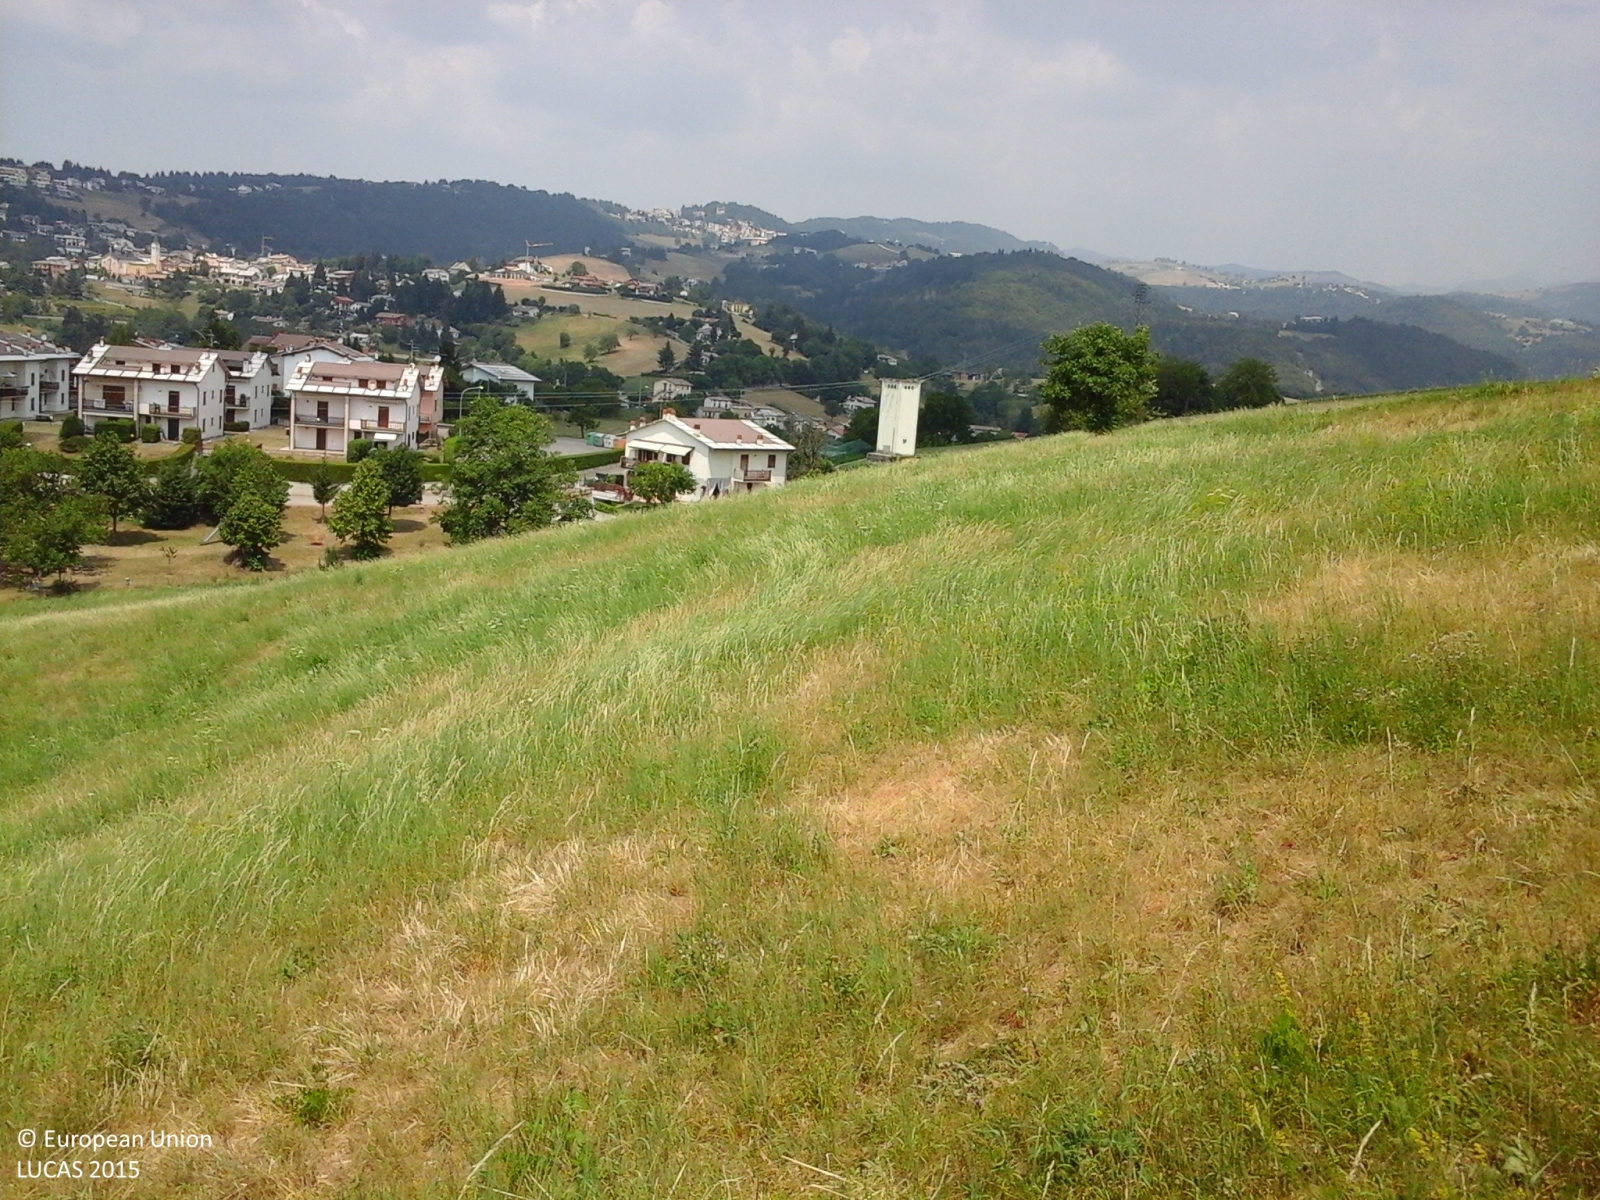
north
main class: Grassland
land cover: Grassland with sparse tree/shrub cover
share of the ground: > 75 %
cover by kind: herbaceous plants 85 %, shrubs 10 %, broadleaved forest trees 5 %
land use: Agriculture (excluding fallow land and kitchen gardens)
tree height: > 5 m
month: July
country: IT
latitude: 45.5894
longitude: 11.0366
